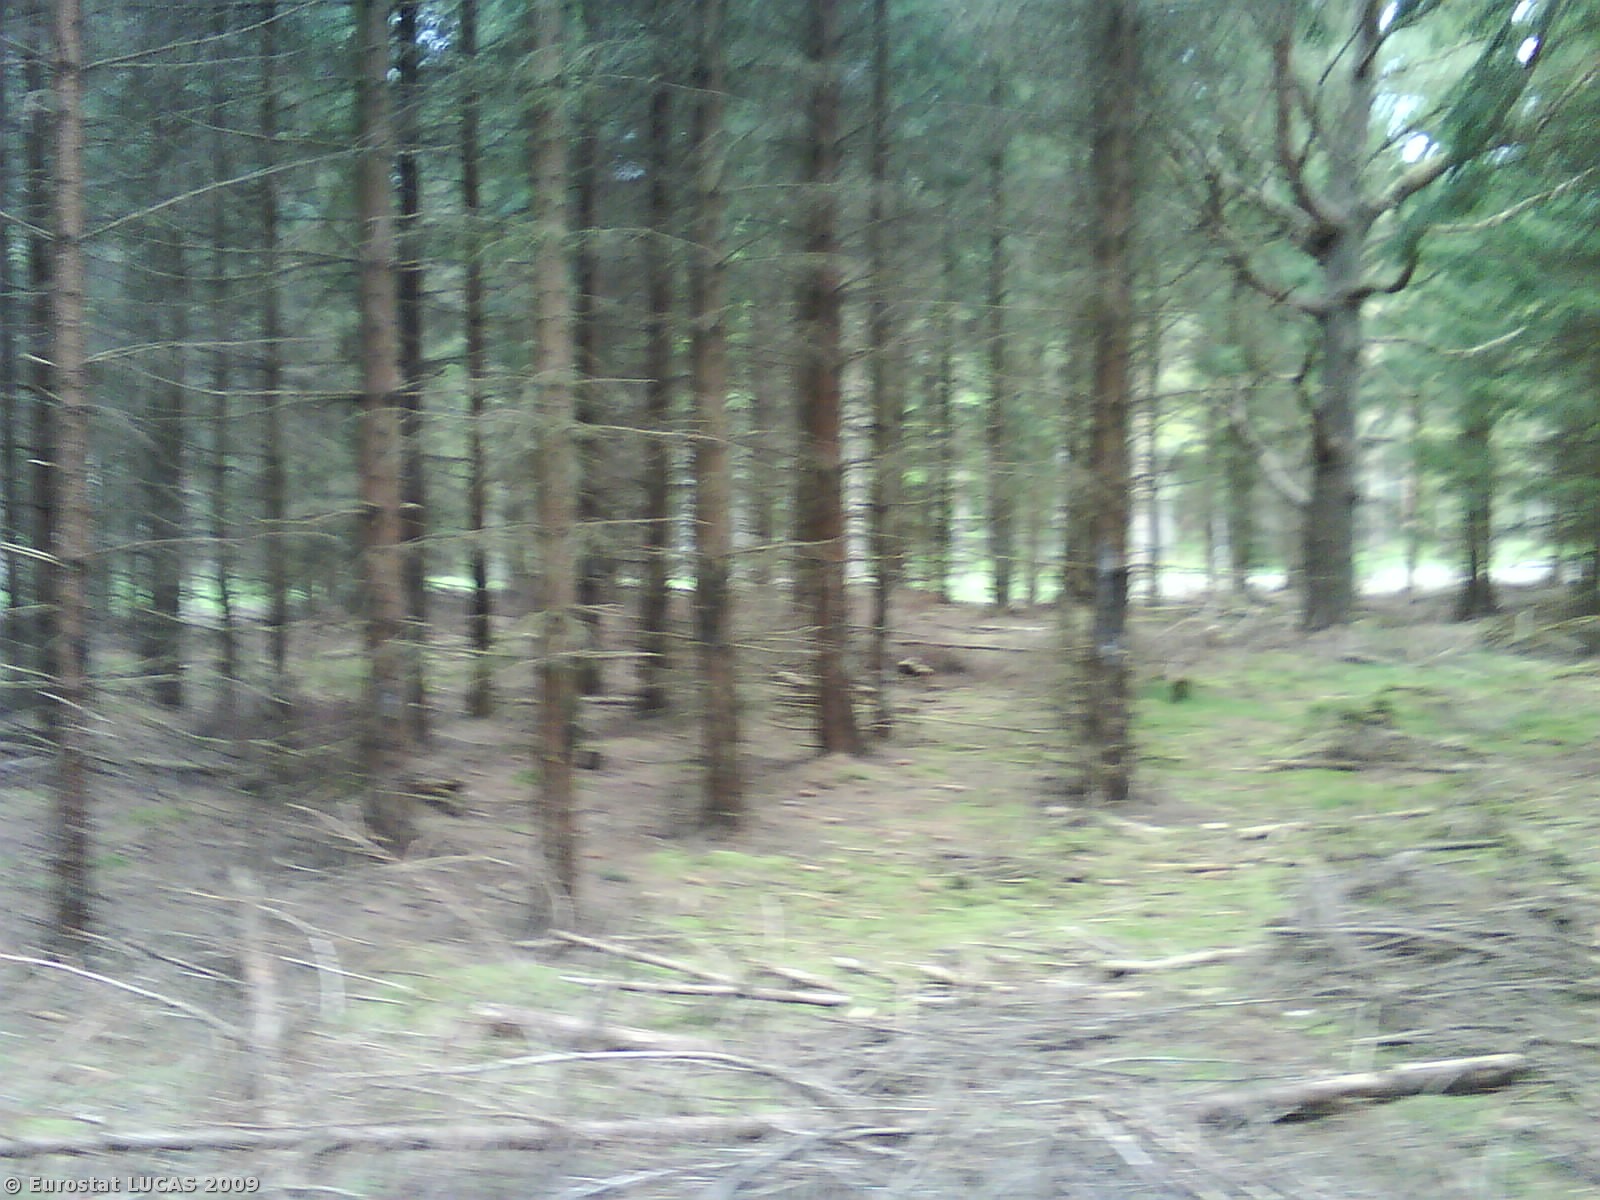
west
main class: Woodland
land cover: Coniferous woodland
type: hemiboreal forest and nemoral coniferous forest and mixed broadleaved-coniferous forest
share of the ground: 25 - 50 %
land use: Forestry
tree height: > 5 m
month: May
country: DK
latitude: 56.5091
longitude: 10.7627
